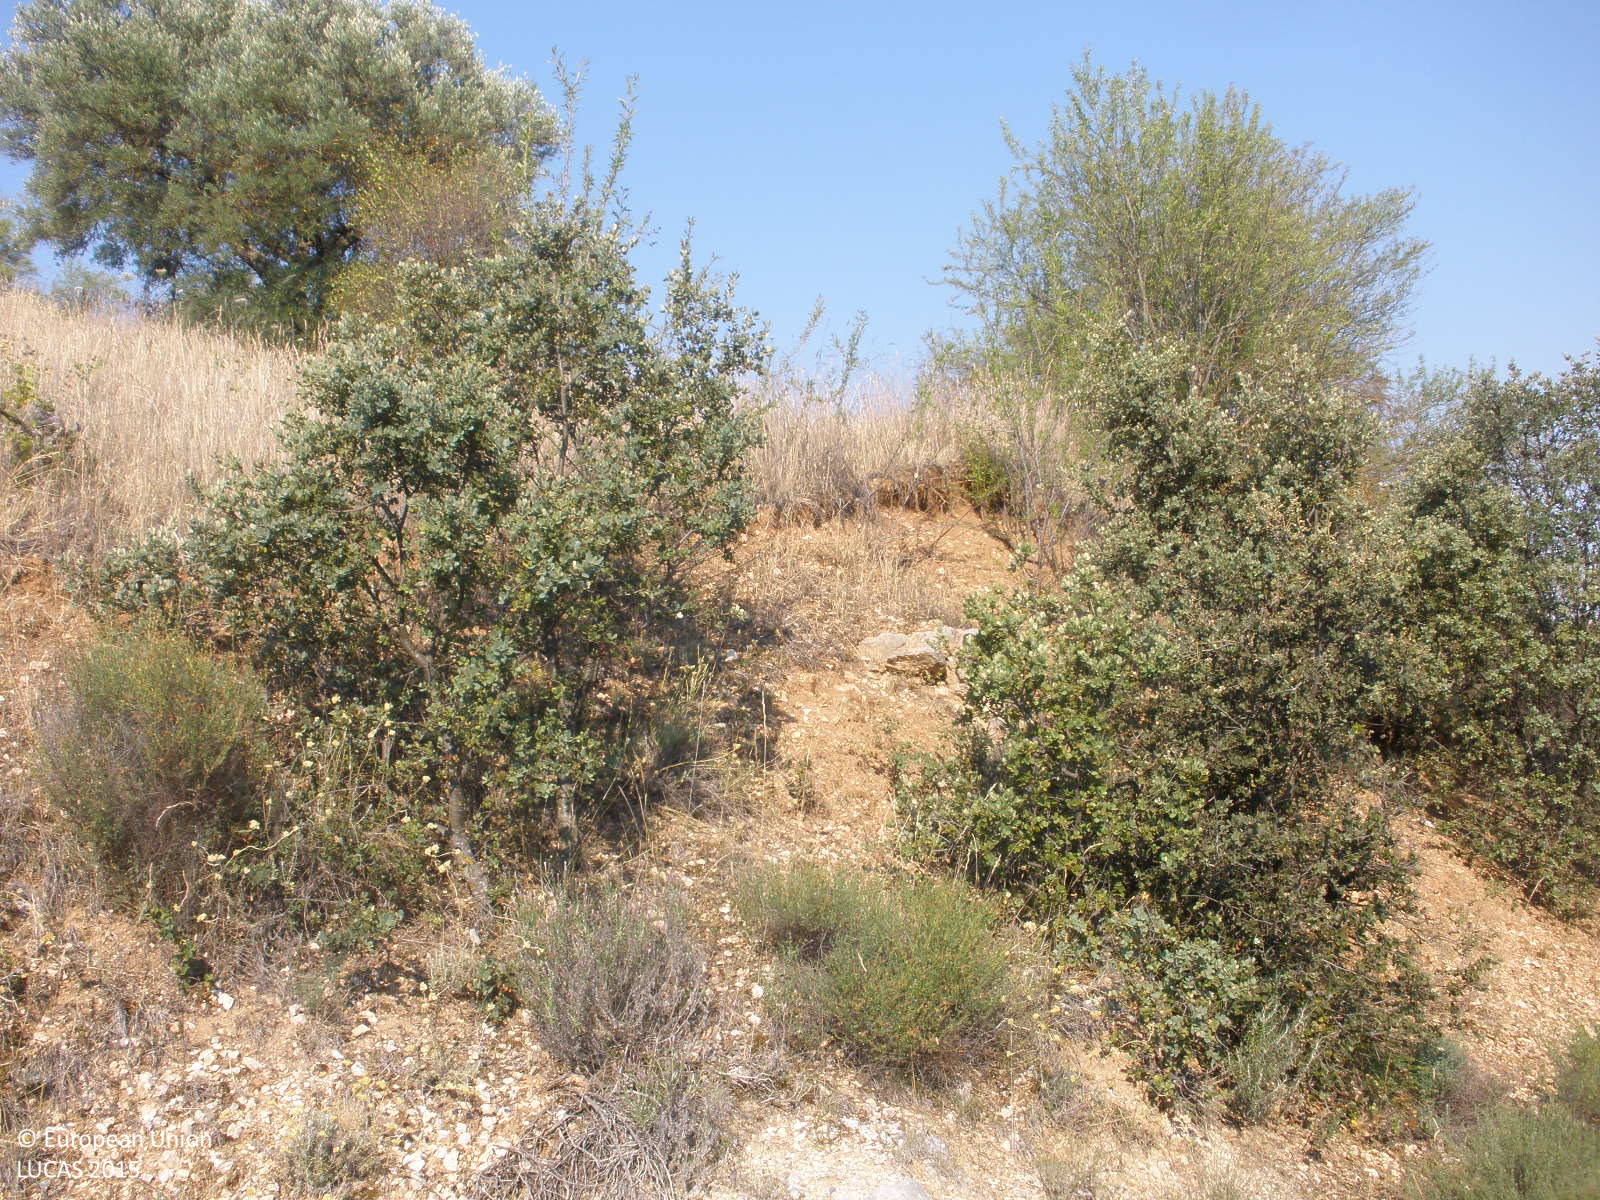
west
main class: Shrubland
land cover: Shrubland with sparse tree cover
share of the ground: 50 - 75 %
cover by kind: shrubs 60 %, herbaceous plants 25 %, consolidated bare surface 10 %, broadleaved forest trees 5 %
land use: Semi-natural and natural areas not in use
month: June
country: ES
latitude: 40.2927
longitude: -3.2883
